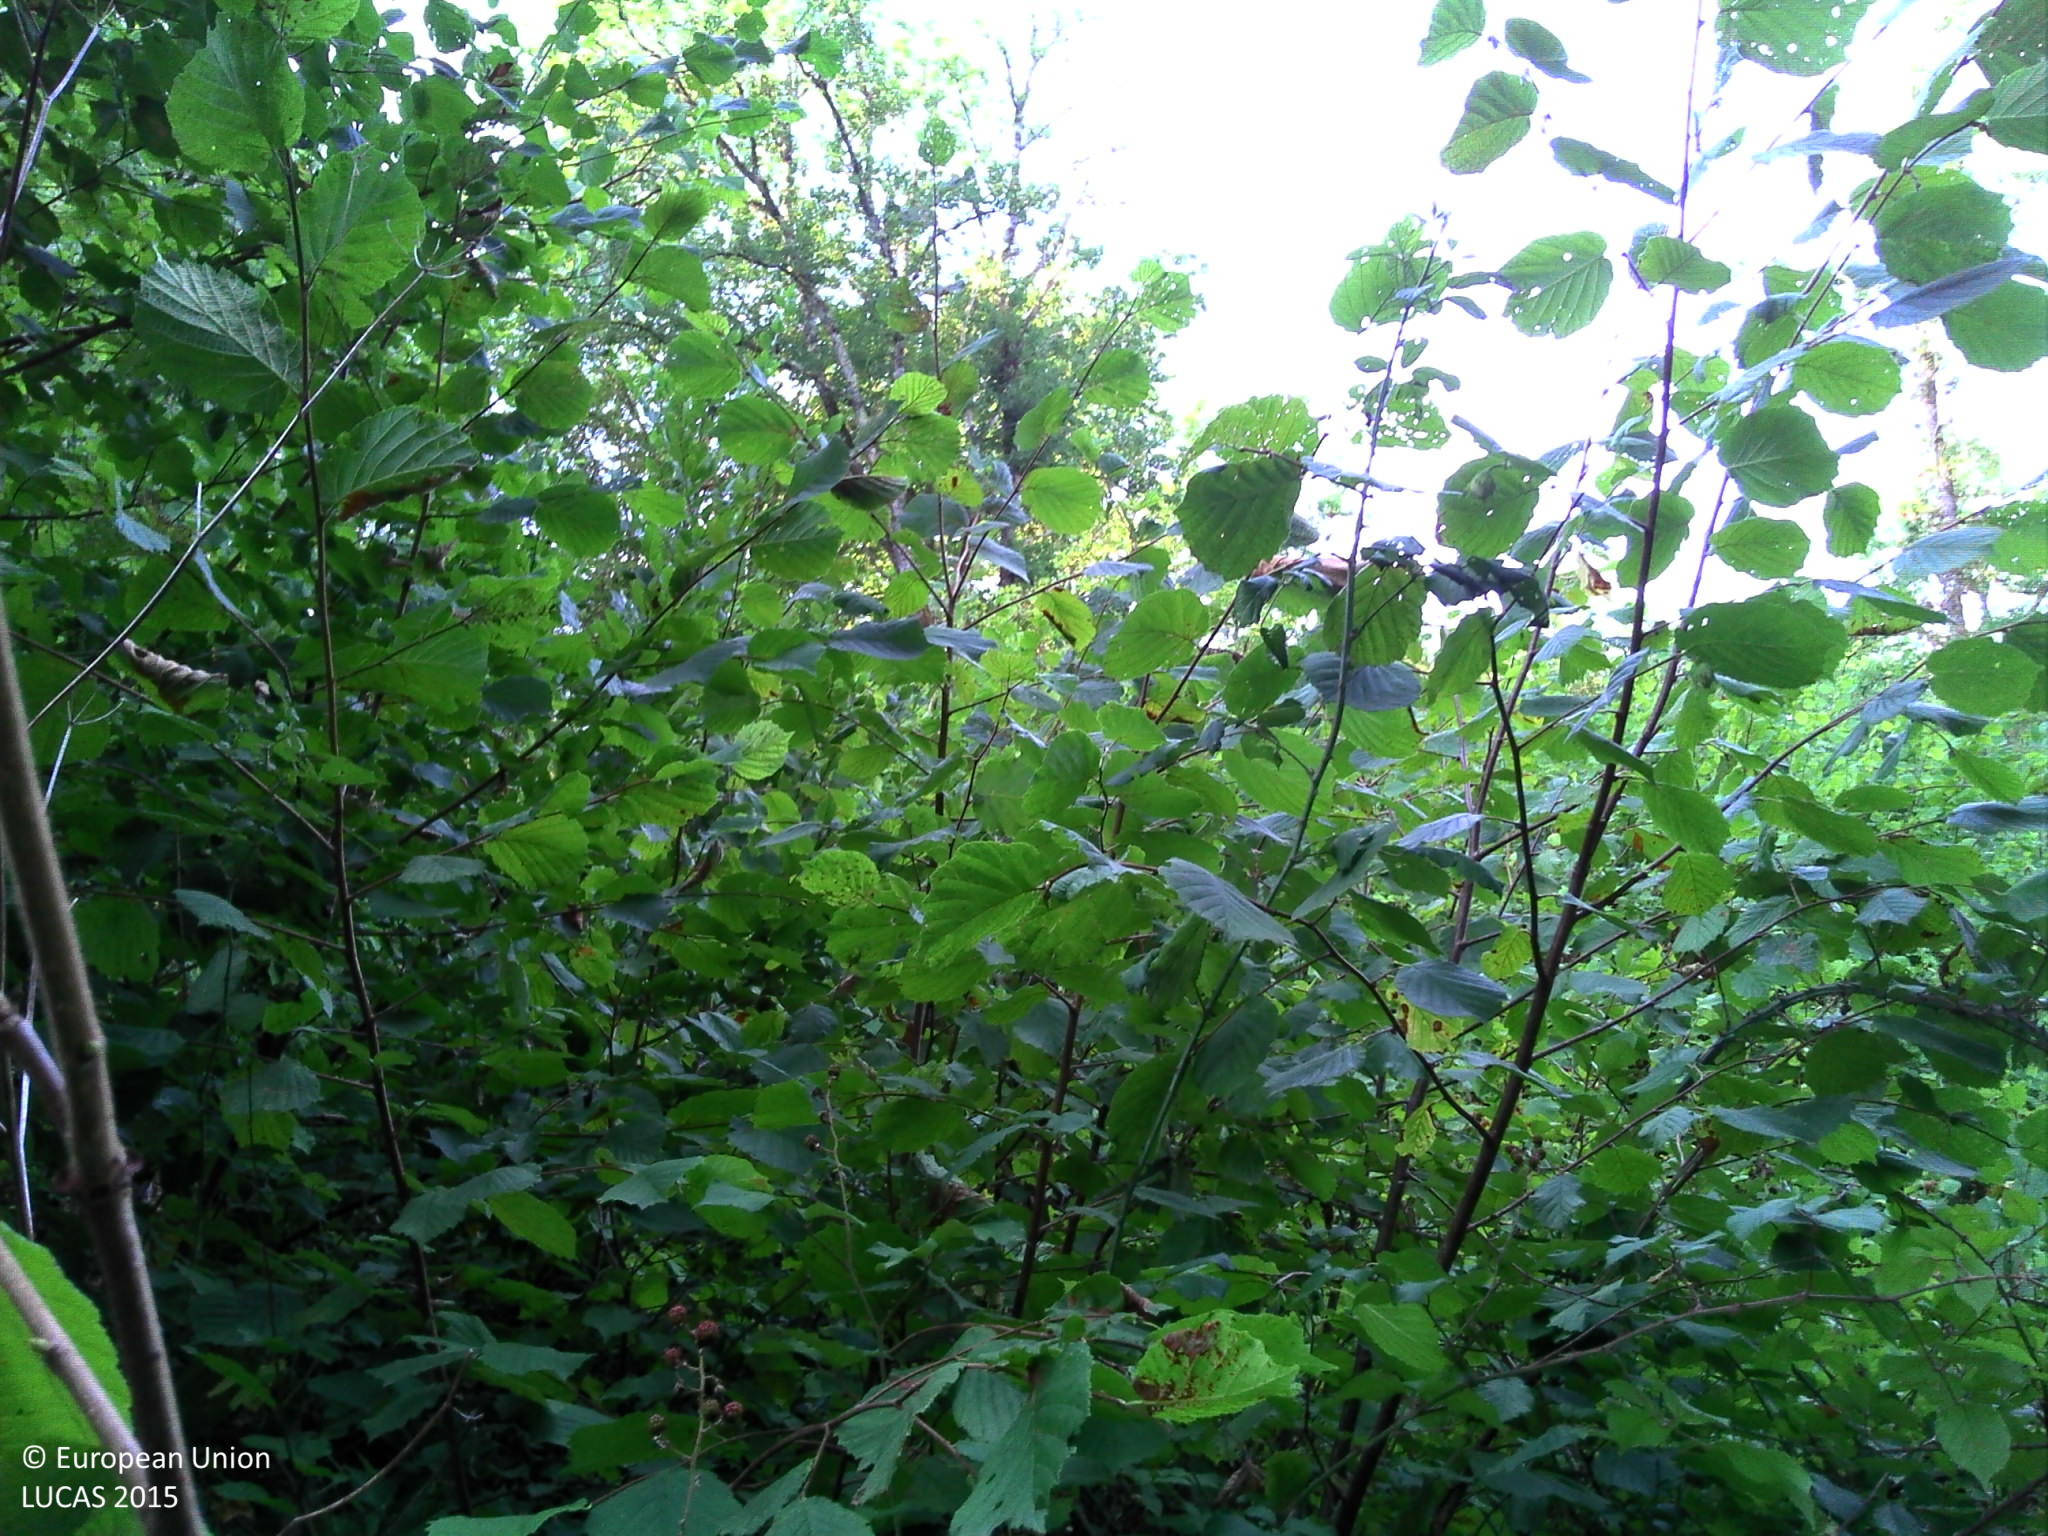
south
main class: Grassland
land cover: Spontaneously vegetated surfaces
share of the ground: > 75 %
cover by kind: herbaceous plants 95 %, shrubs 5 %
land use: Semi-natural and natural areas not in use
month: August
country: FR
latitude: 44.8444
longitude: 1.1765
